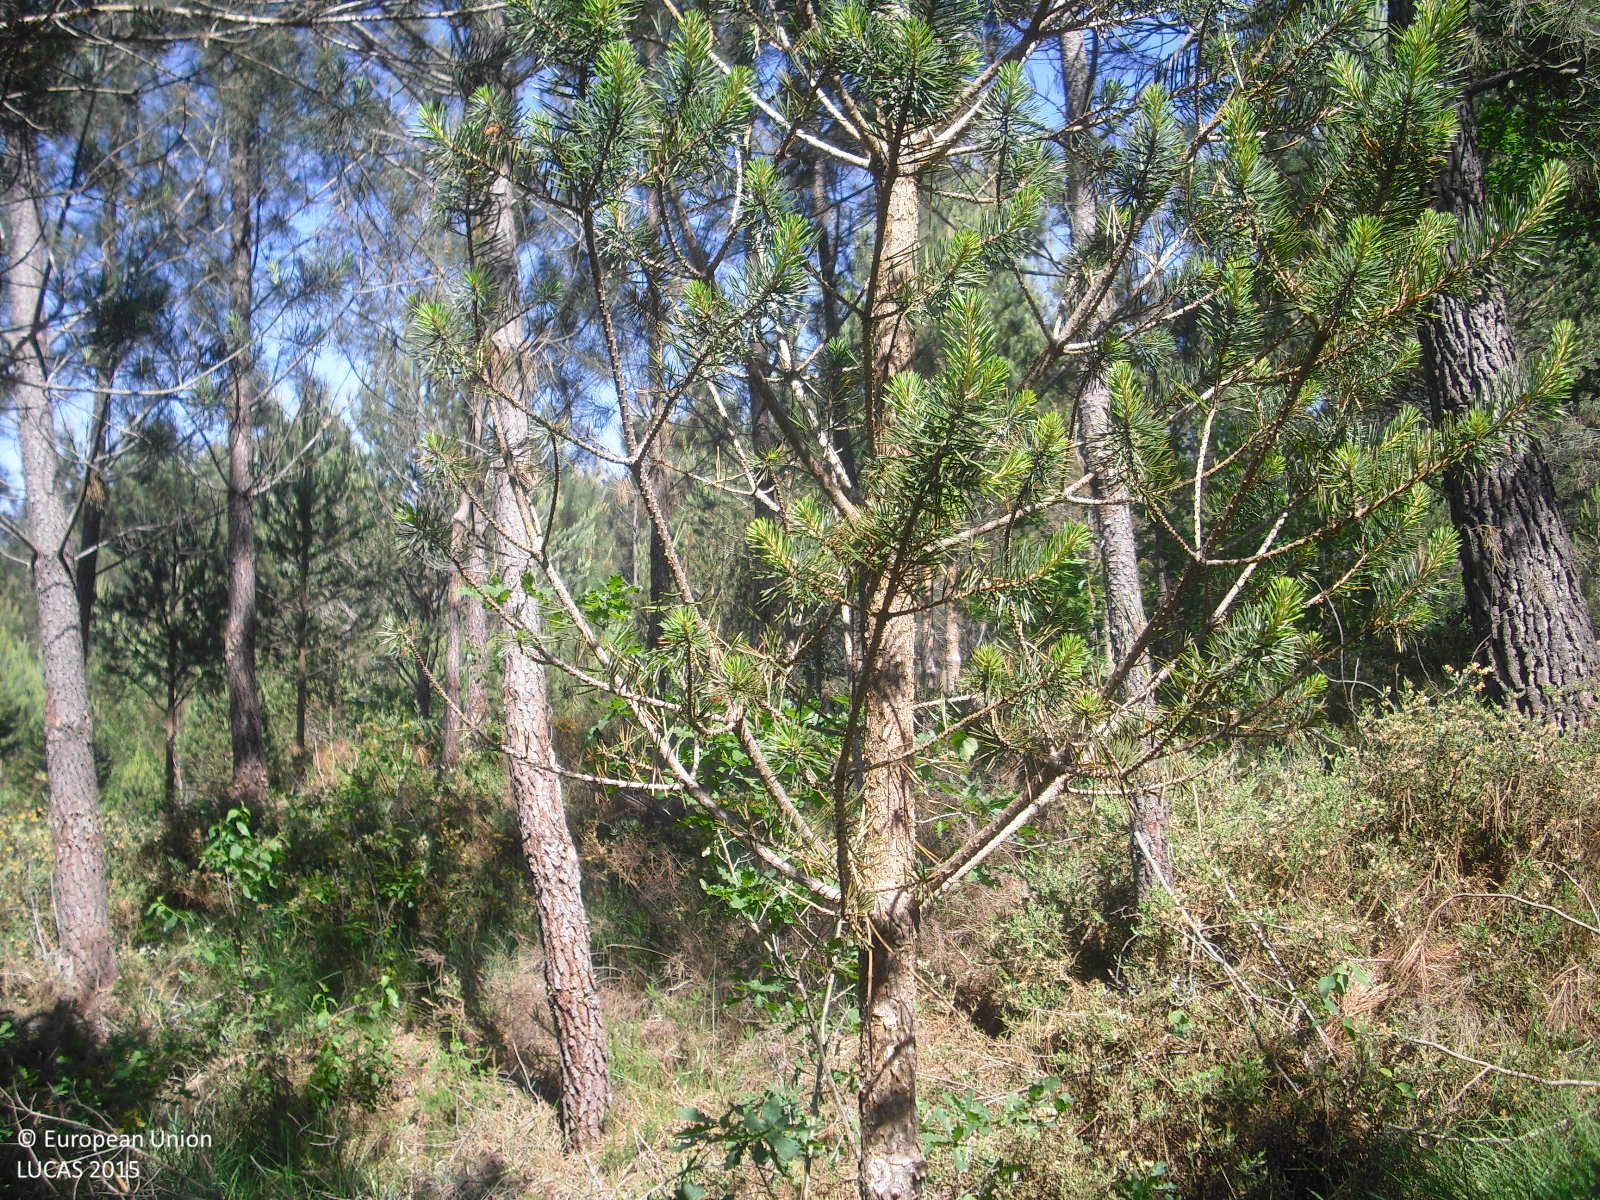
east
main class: Woodland
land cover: Pine dominated coniferous woodland
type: hemiboreal forest and nemoral coniferous forest and mixed broadleaved-coniferous forest
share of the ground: > 75 %
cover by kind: coniferous forest trees 80 %, shrubs 15 %, broadleaved forest trees 5 %
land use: Forestry
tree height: > 5 m
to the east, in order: Pine dominated coniferous woodland; Ditches and canals; Paved roads, cycling and walking lanes; Ditches and canals; Other structural elements; Electric lines; Other structural elements; Pine dominated coniferous woodland
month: May
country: ES
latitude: 42.2368
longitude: -7.6279
